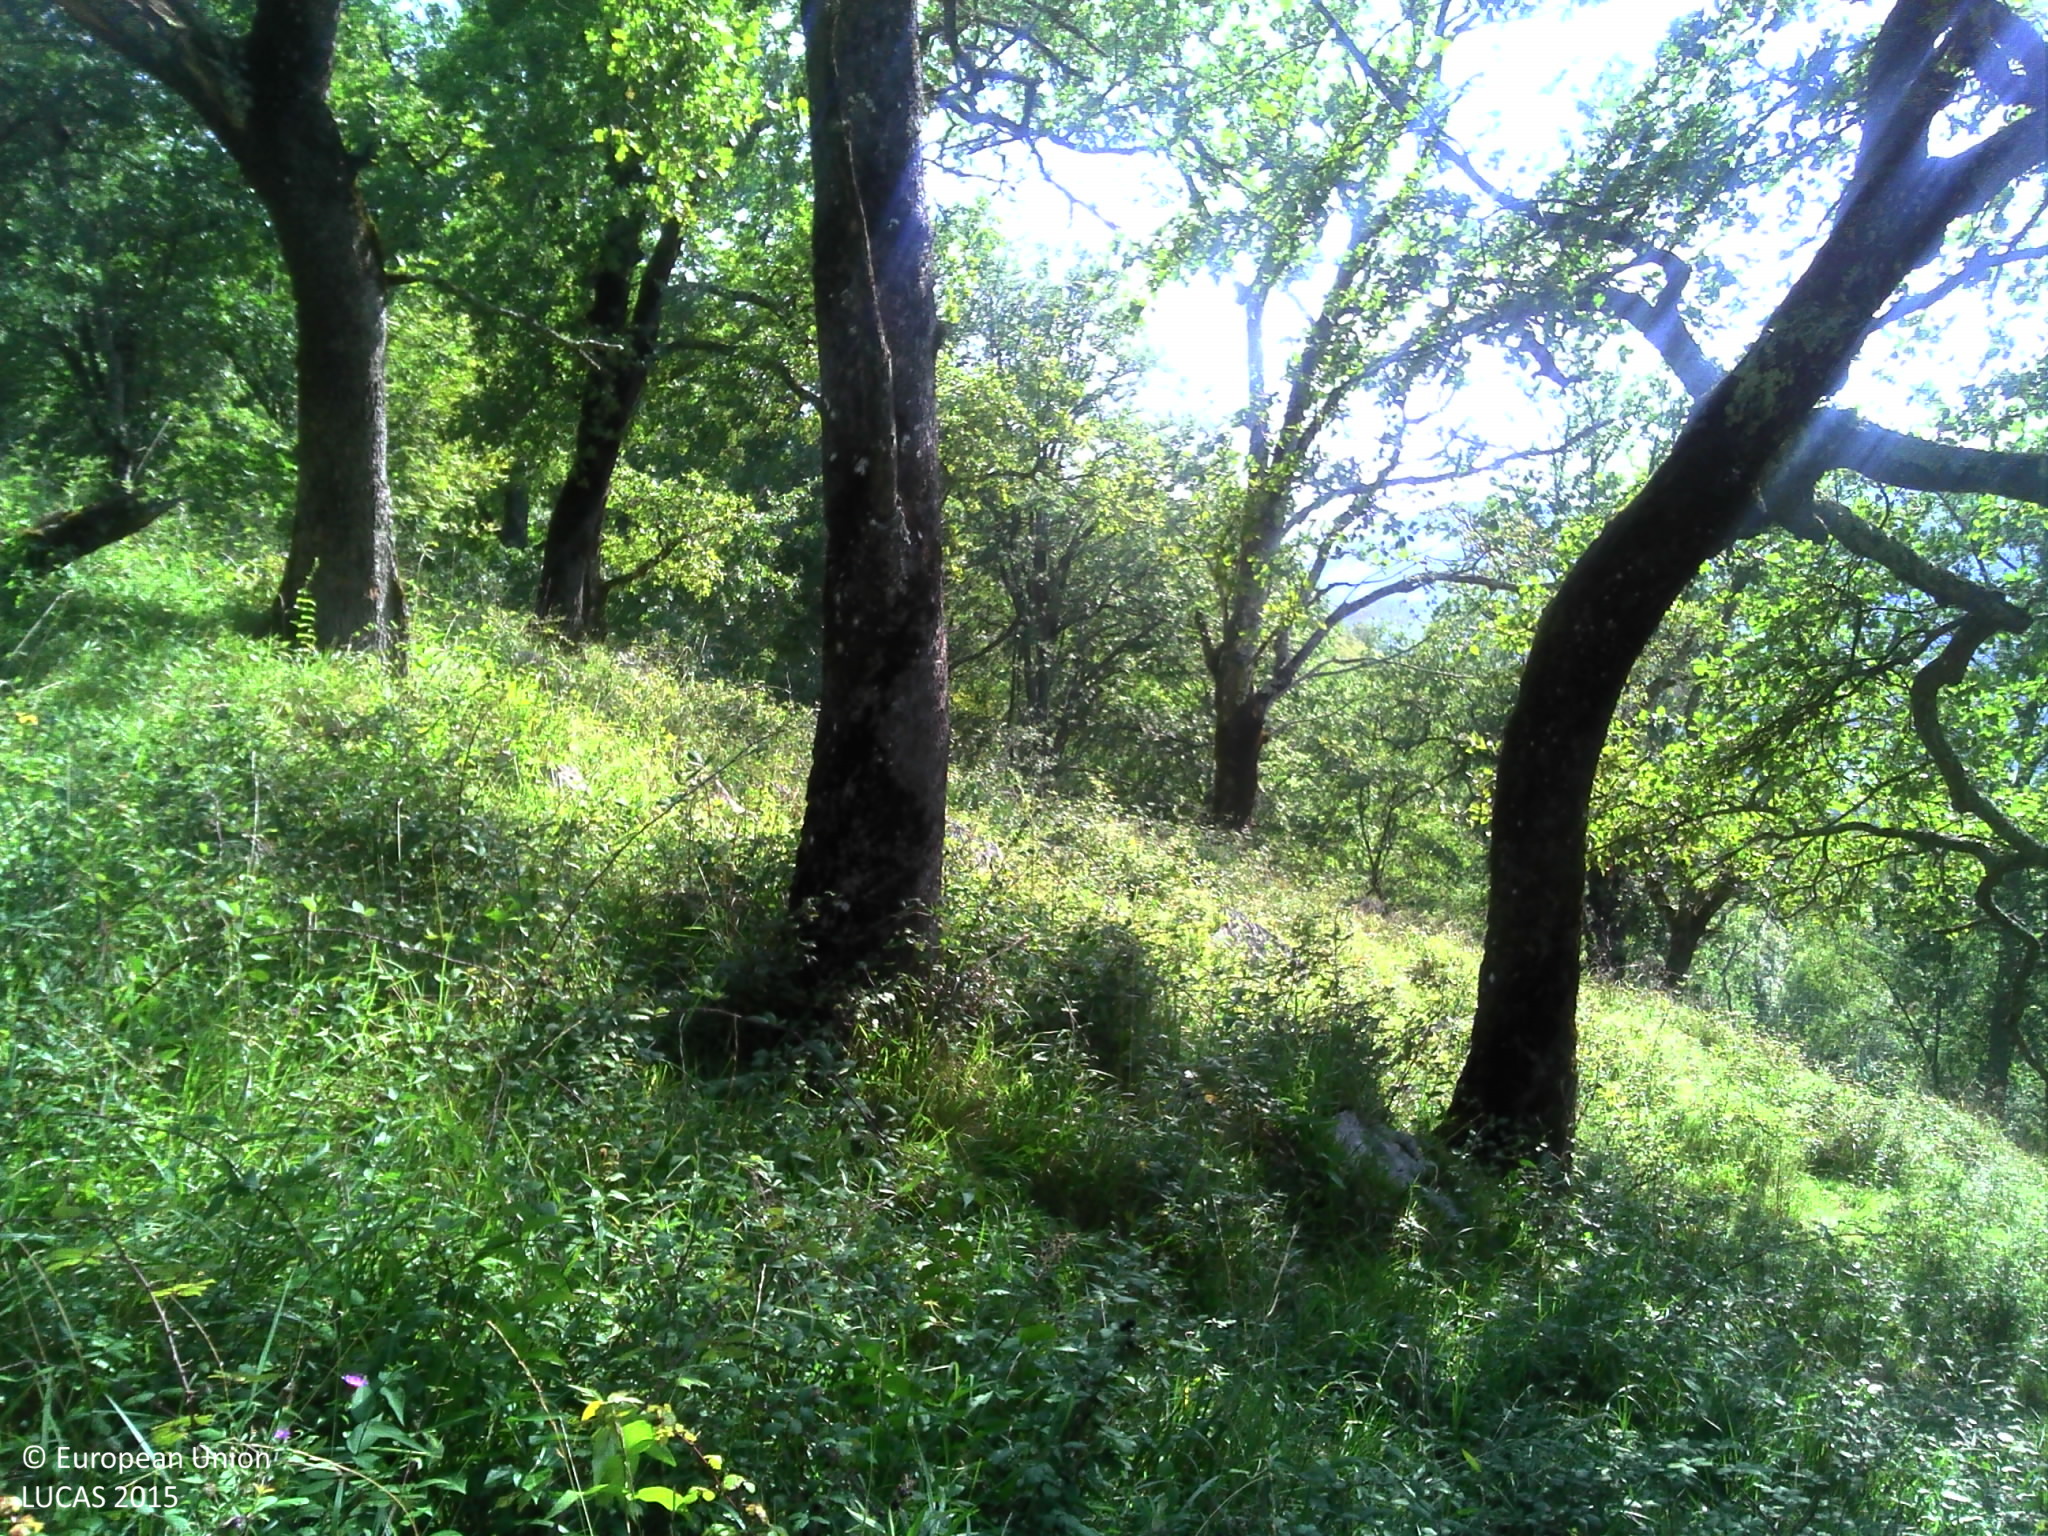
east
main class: Woodland
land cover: Broadleaved woodland
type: acidophilous oak and oak-birch forest
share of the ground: 25 - 50 %
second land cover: Grassland without tree/shrub cover
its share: 50 - 75 %
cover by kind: broadleaved forest trees 40 %, herbaceous plants 40 %, shrubs 15 %, consolidated bare surface 5 %
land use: Forestry
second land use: Agriculture (excluding fallow land and kitchen gardens)
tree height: > 5 m
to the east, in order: Broadleaved woodland; Grassland without tree/shrub cover; Dry stone walls; Broadleaved woodland; Grassland without tree/shrub cover; Electric lines; Grassland without tree/shrub cover; Broadleaved woodland; Grassland without tree/shrub cover; Dry stone walls; Fences; Broadleaved woodland; Rock outcrops; Grassland with sparse tree/shrub cover; Rock outcrops; Grassland without tree/shrub cover; Shrubland with sparse tree cover
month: September
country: FR
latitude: 43.0980
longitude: -0.9325
